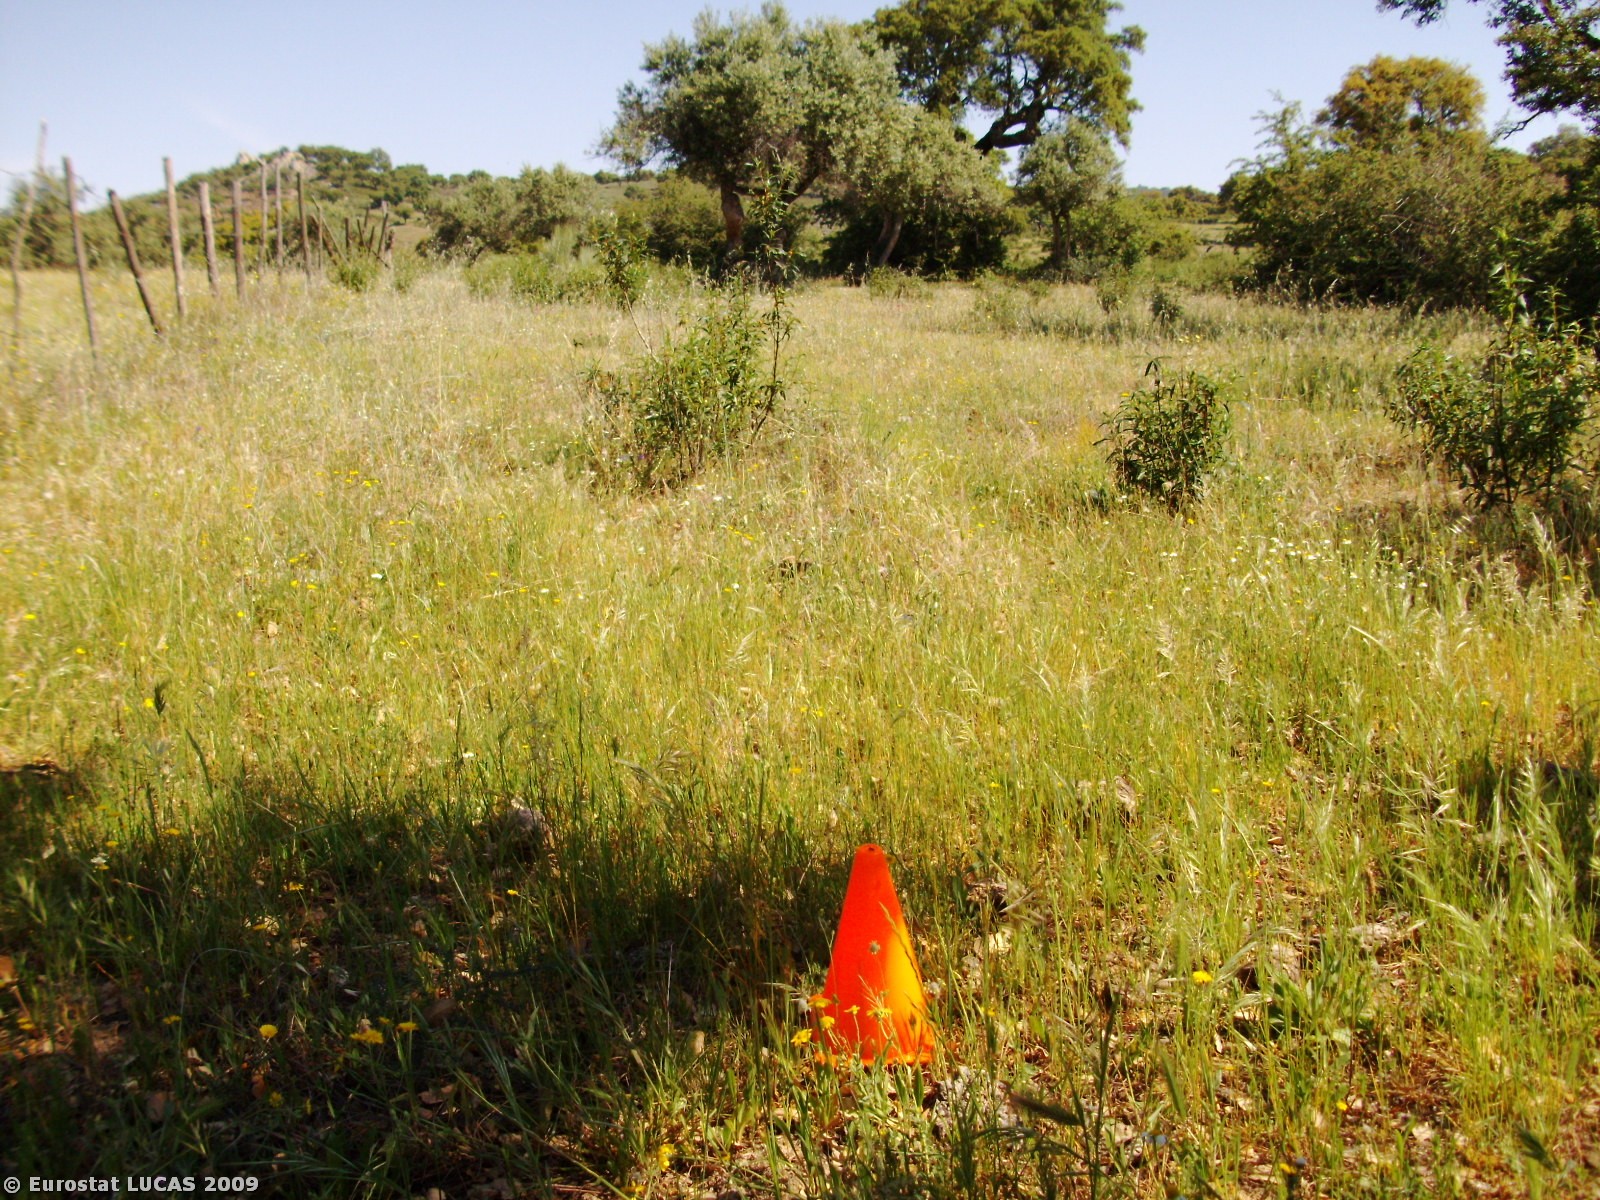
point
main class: Woodland
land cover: Broadleaved woodland
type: broadleaved evergreen forest
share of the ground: 25 - 50 %
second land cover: Grassland with sparse tree/shrub cover
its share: 50 - 75 %
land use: Forestry
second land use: Agriculture (excluding fallow land and kitchen gardens)
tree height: > 5 m
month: May
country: PT
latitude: 39.2685
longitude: -7.4150
